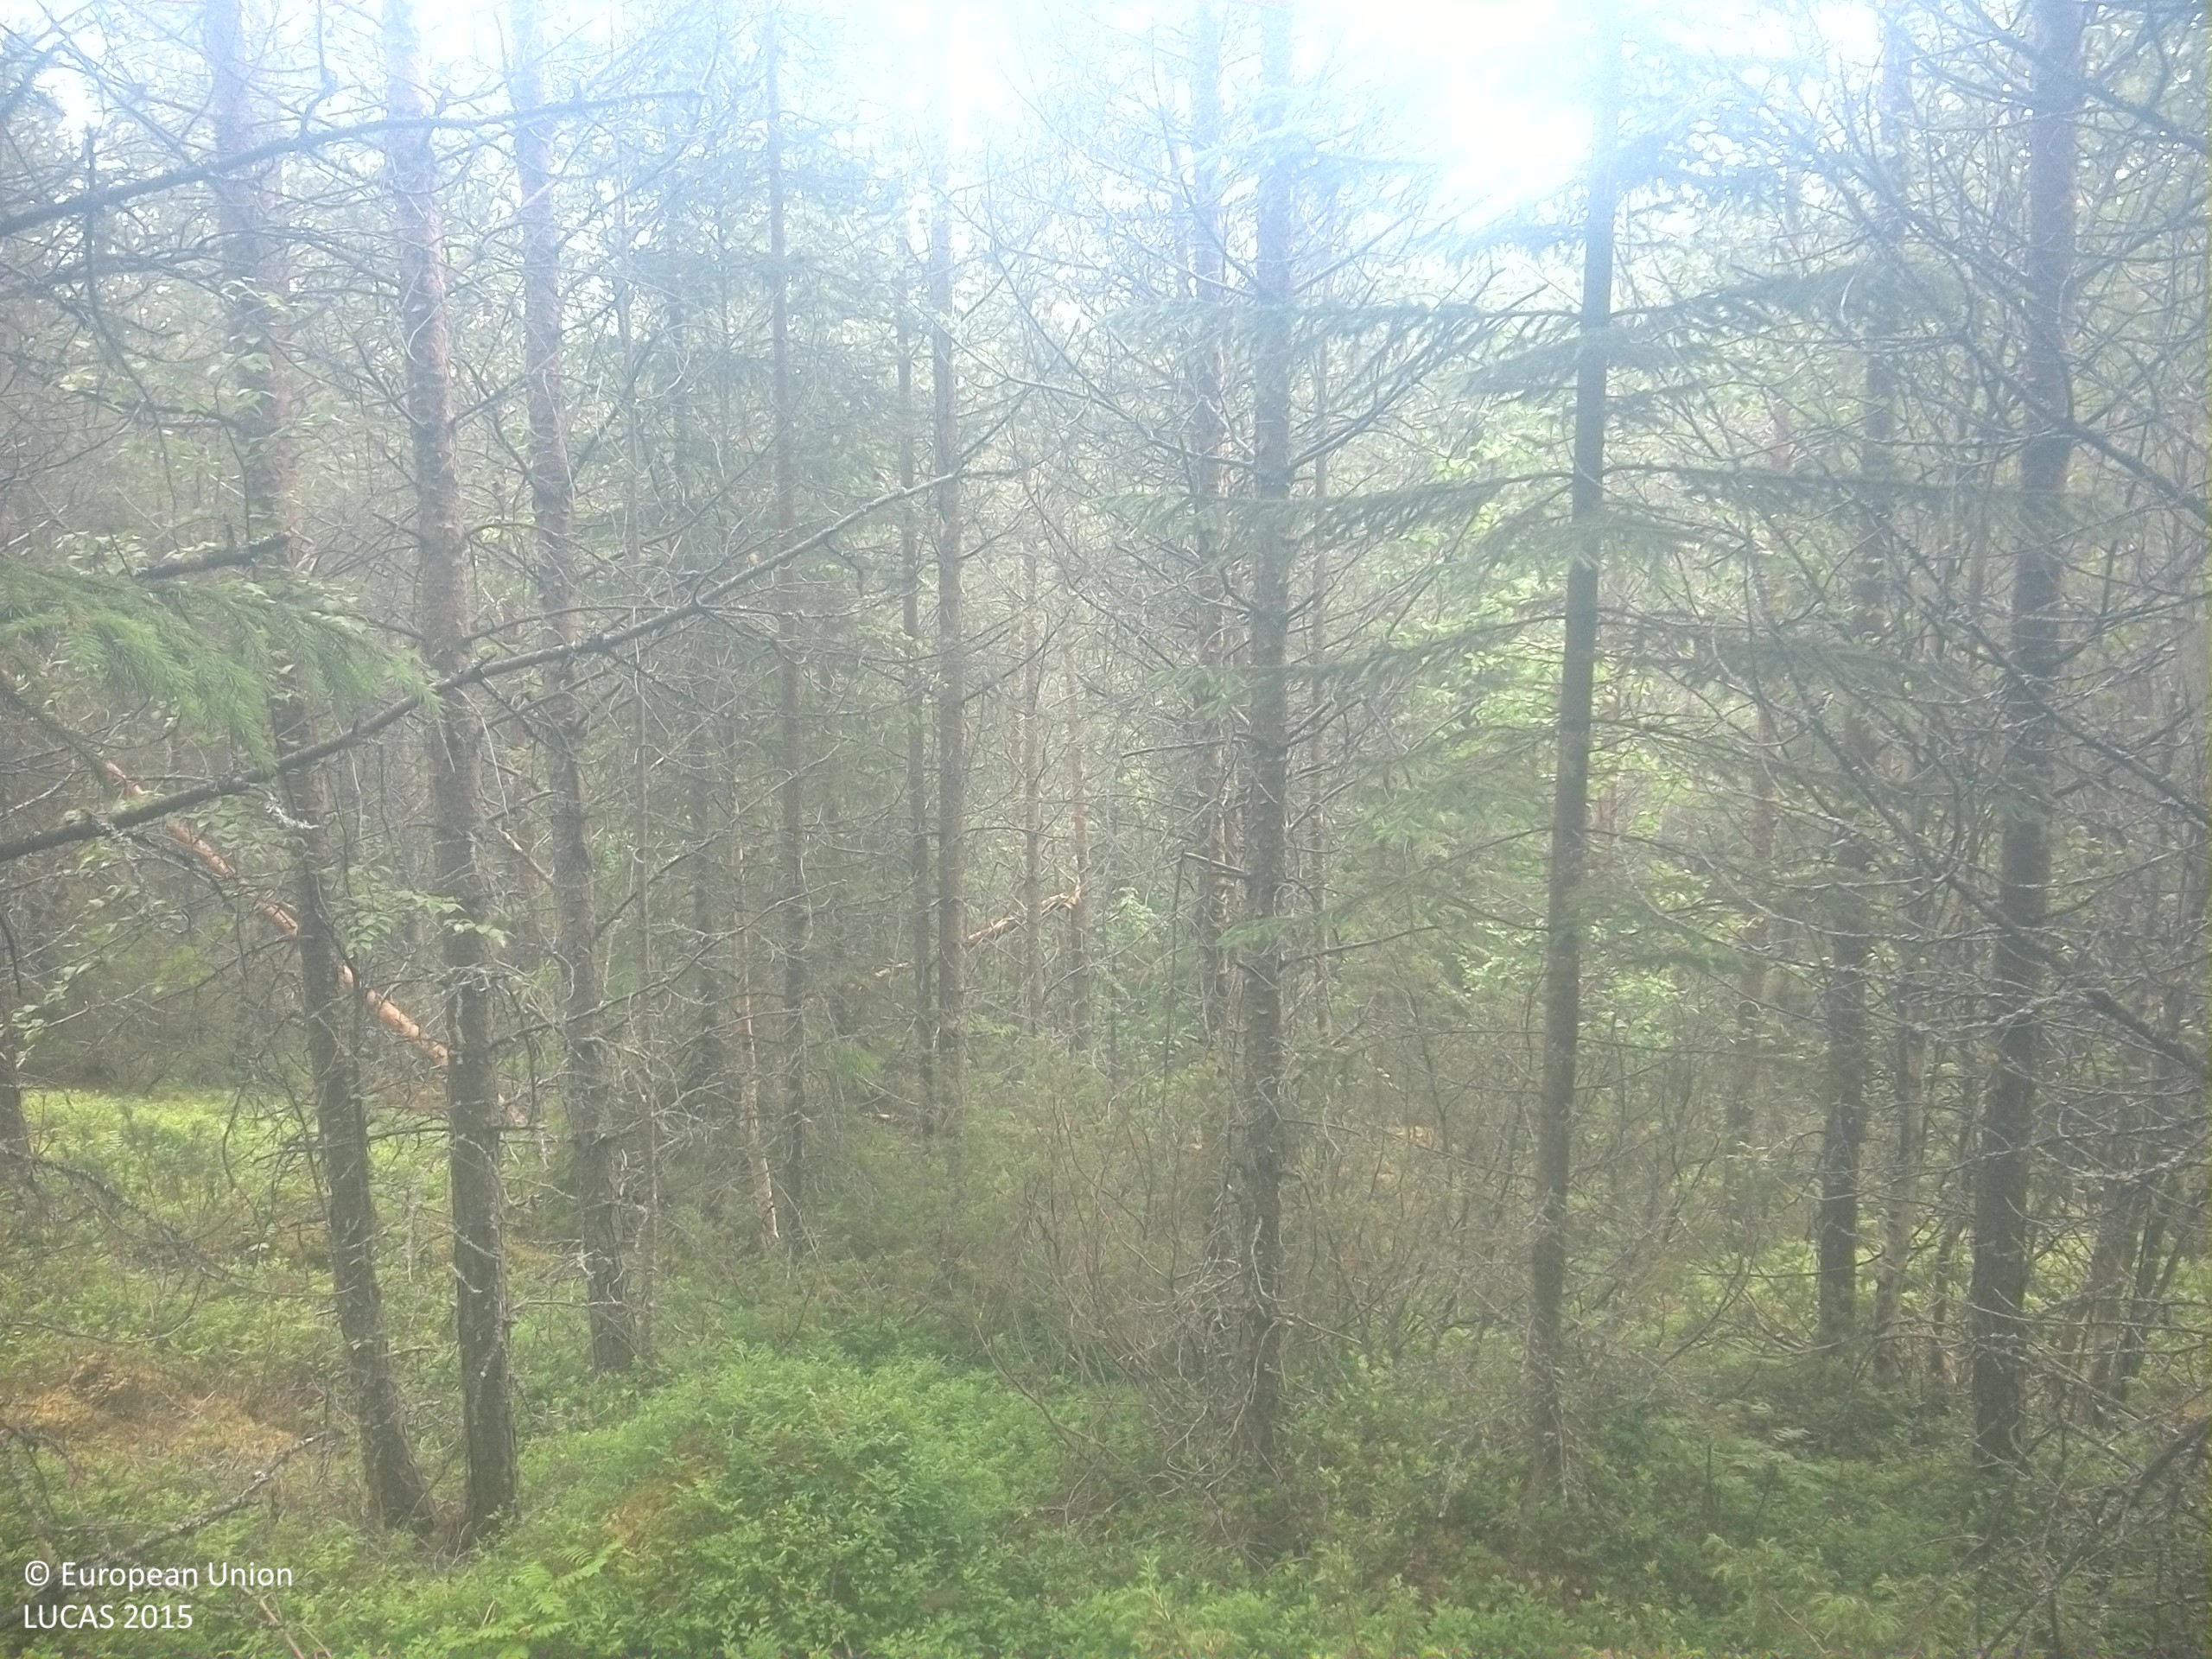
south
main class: Woodland
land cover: Pine dominated coniferous woodland
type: boreal forest
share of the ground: 50 - 75 %
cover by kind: coniferous forest trees 50 %, shrubs 30 %, lichens and mosses 10 %, broadleaved forest trees 5 %, consolidated bare surface 5 %
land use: Forestry
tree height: > 5 m
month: July
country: SE
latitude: 64.1824
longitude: 16.7404
